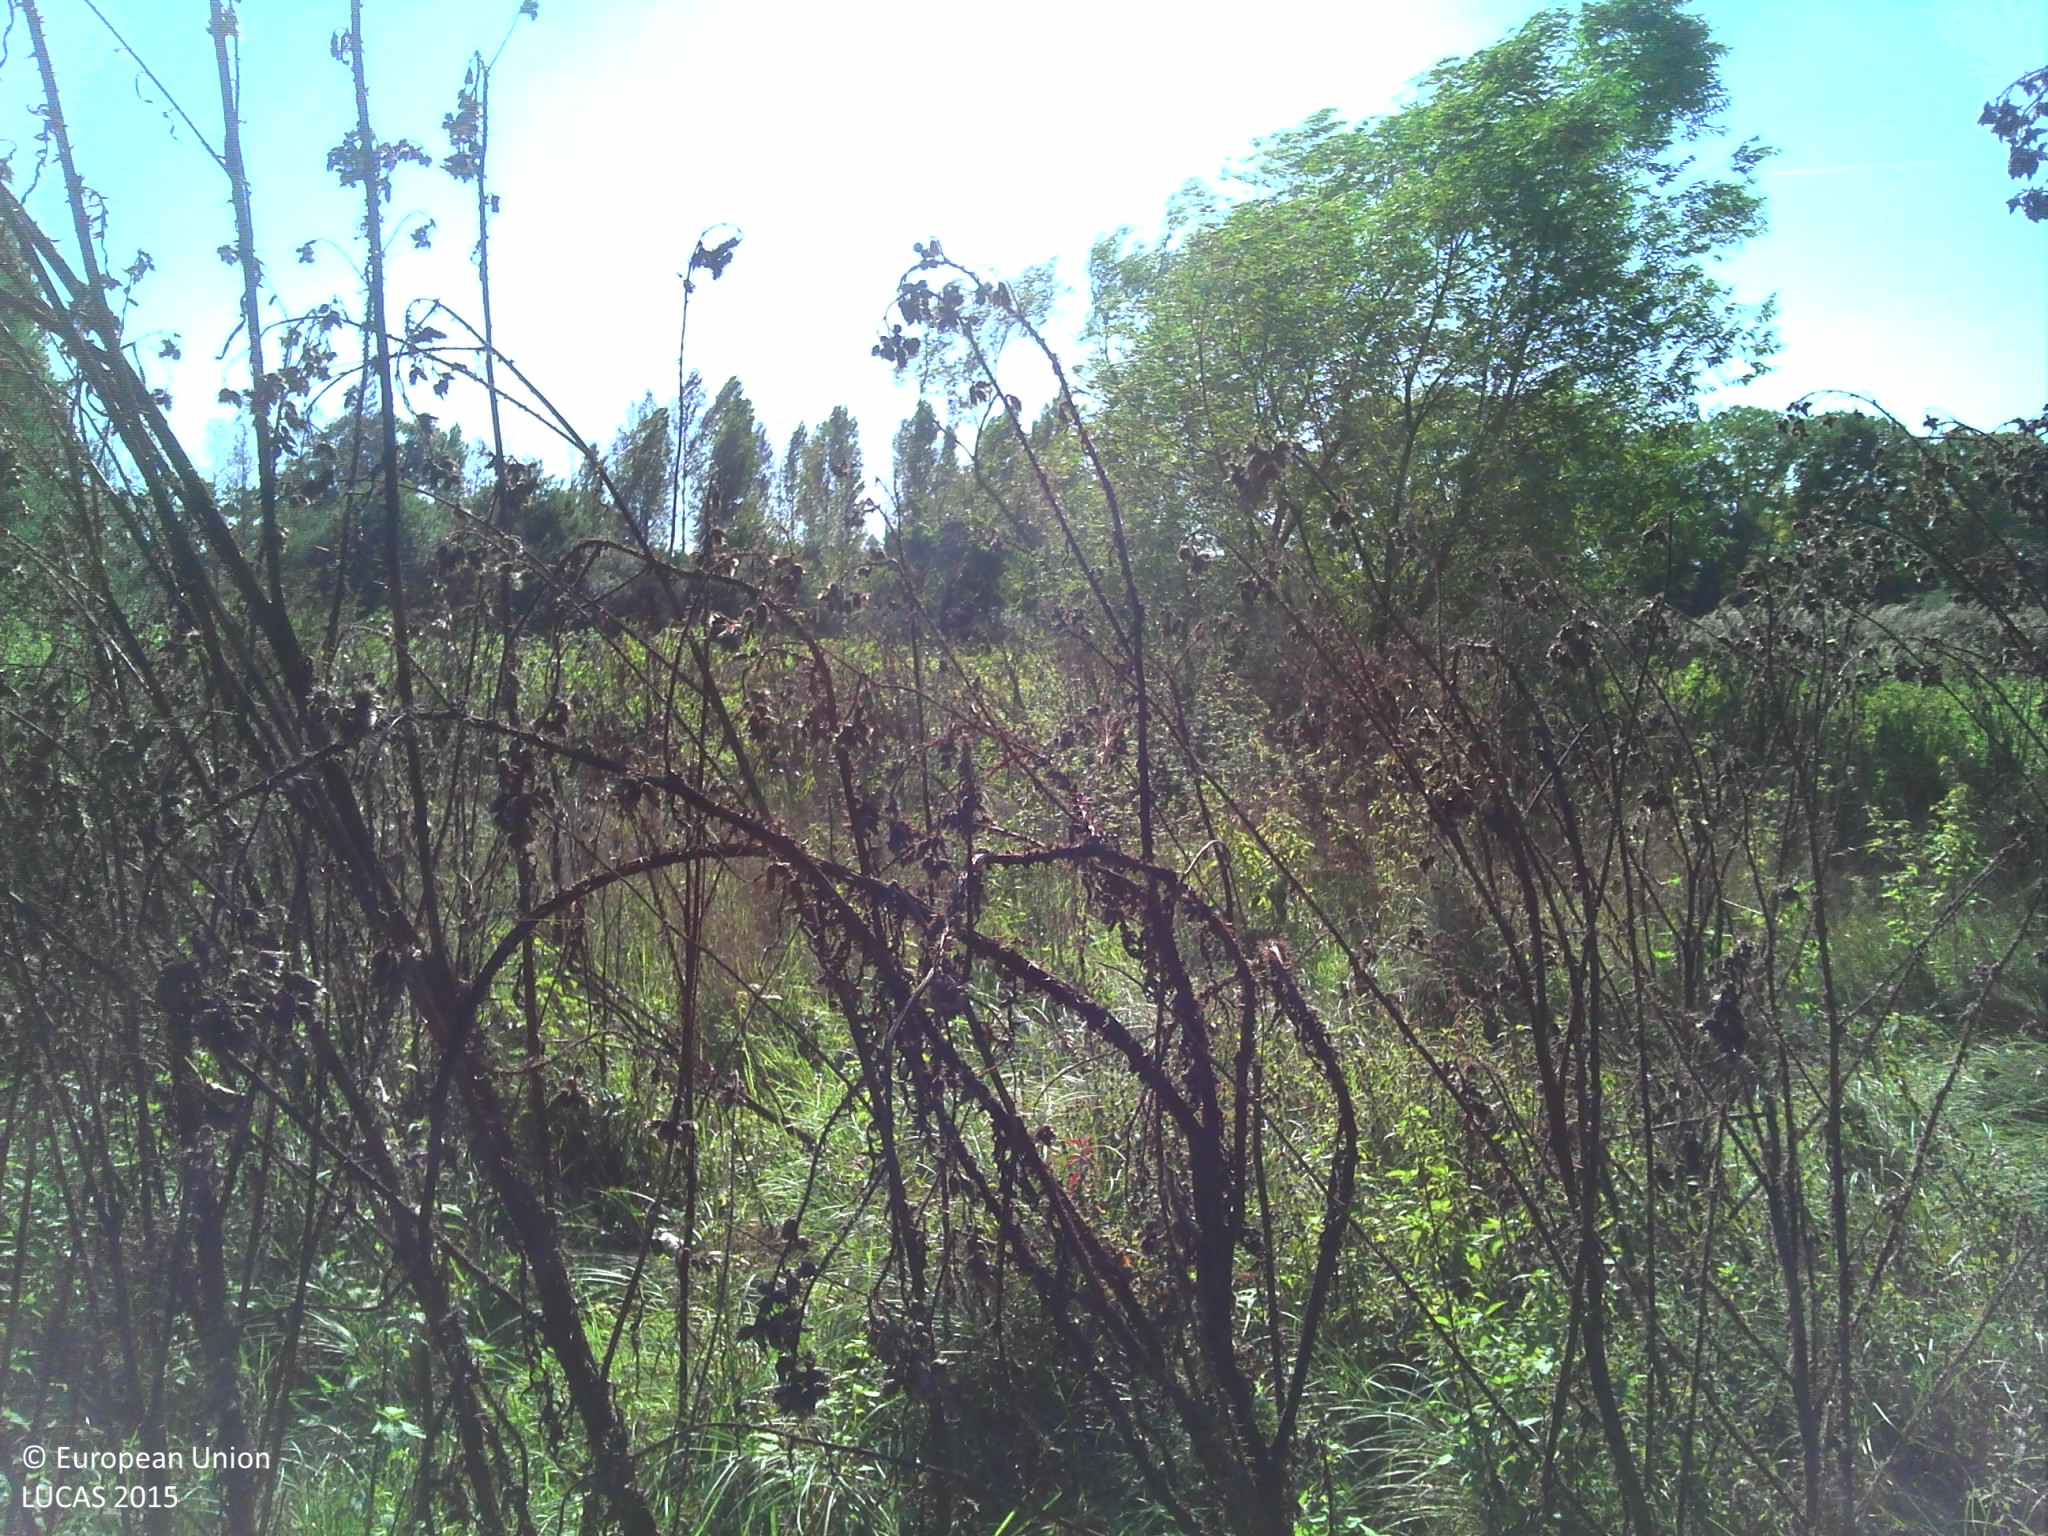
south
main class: Grassland
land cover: Spontaneously vegetated surfaces
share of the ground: > 75 %
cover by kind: herbaceous plants 100 %
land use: Semi-natural and natural areas not in use
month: September
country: BE
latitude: 51.1829
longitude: 4.8035
